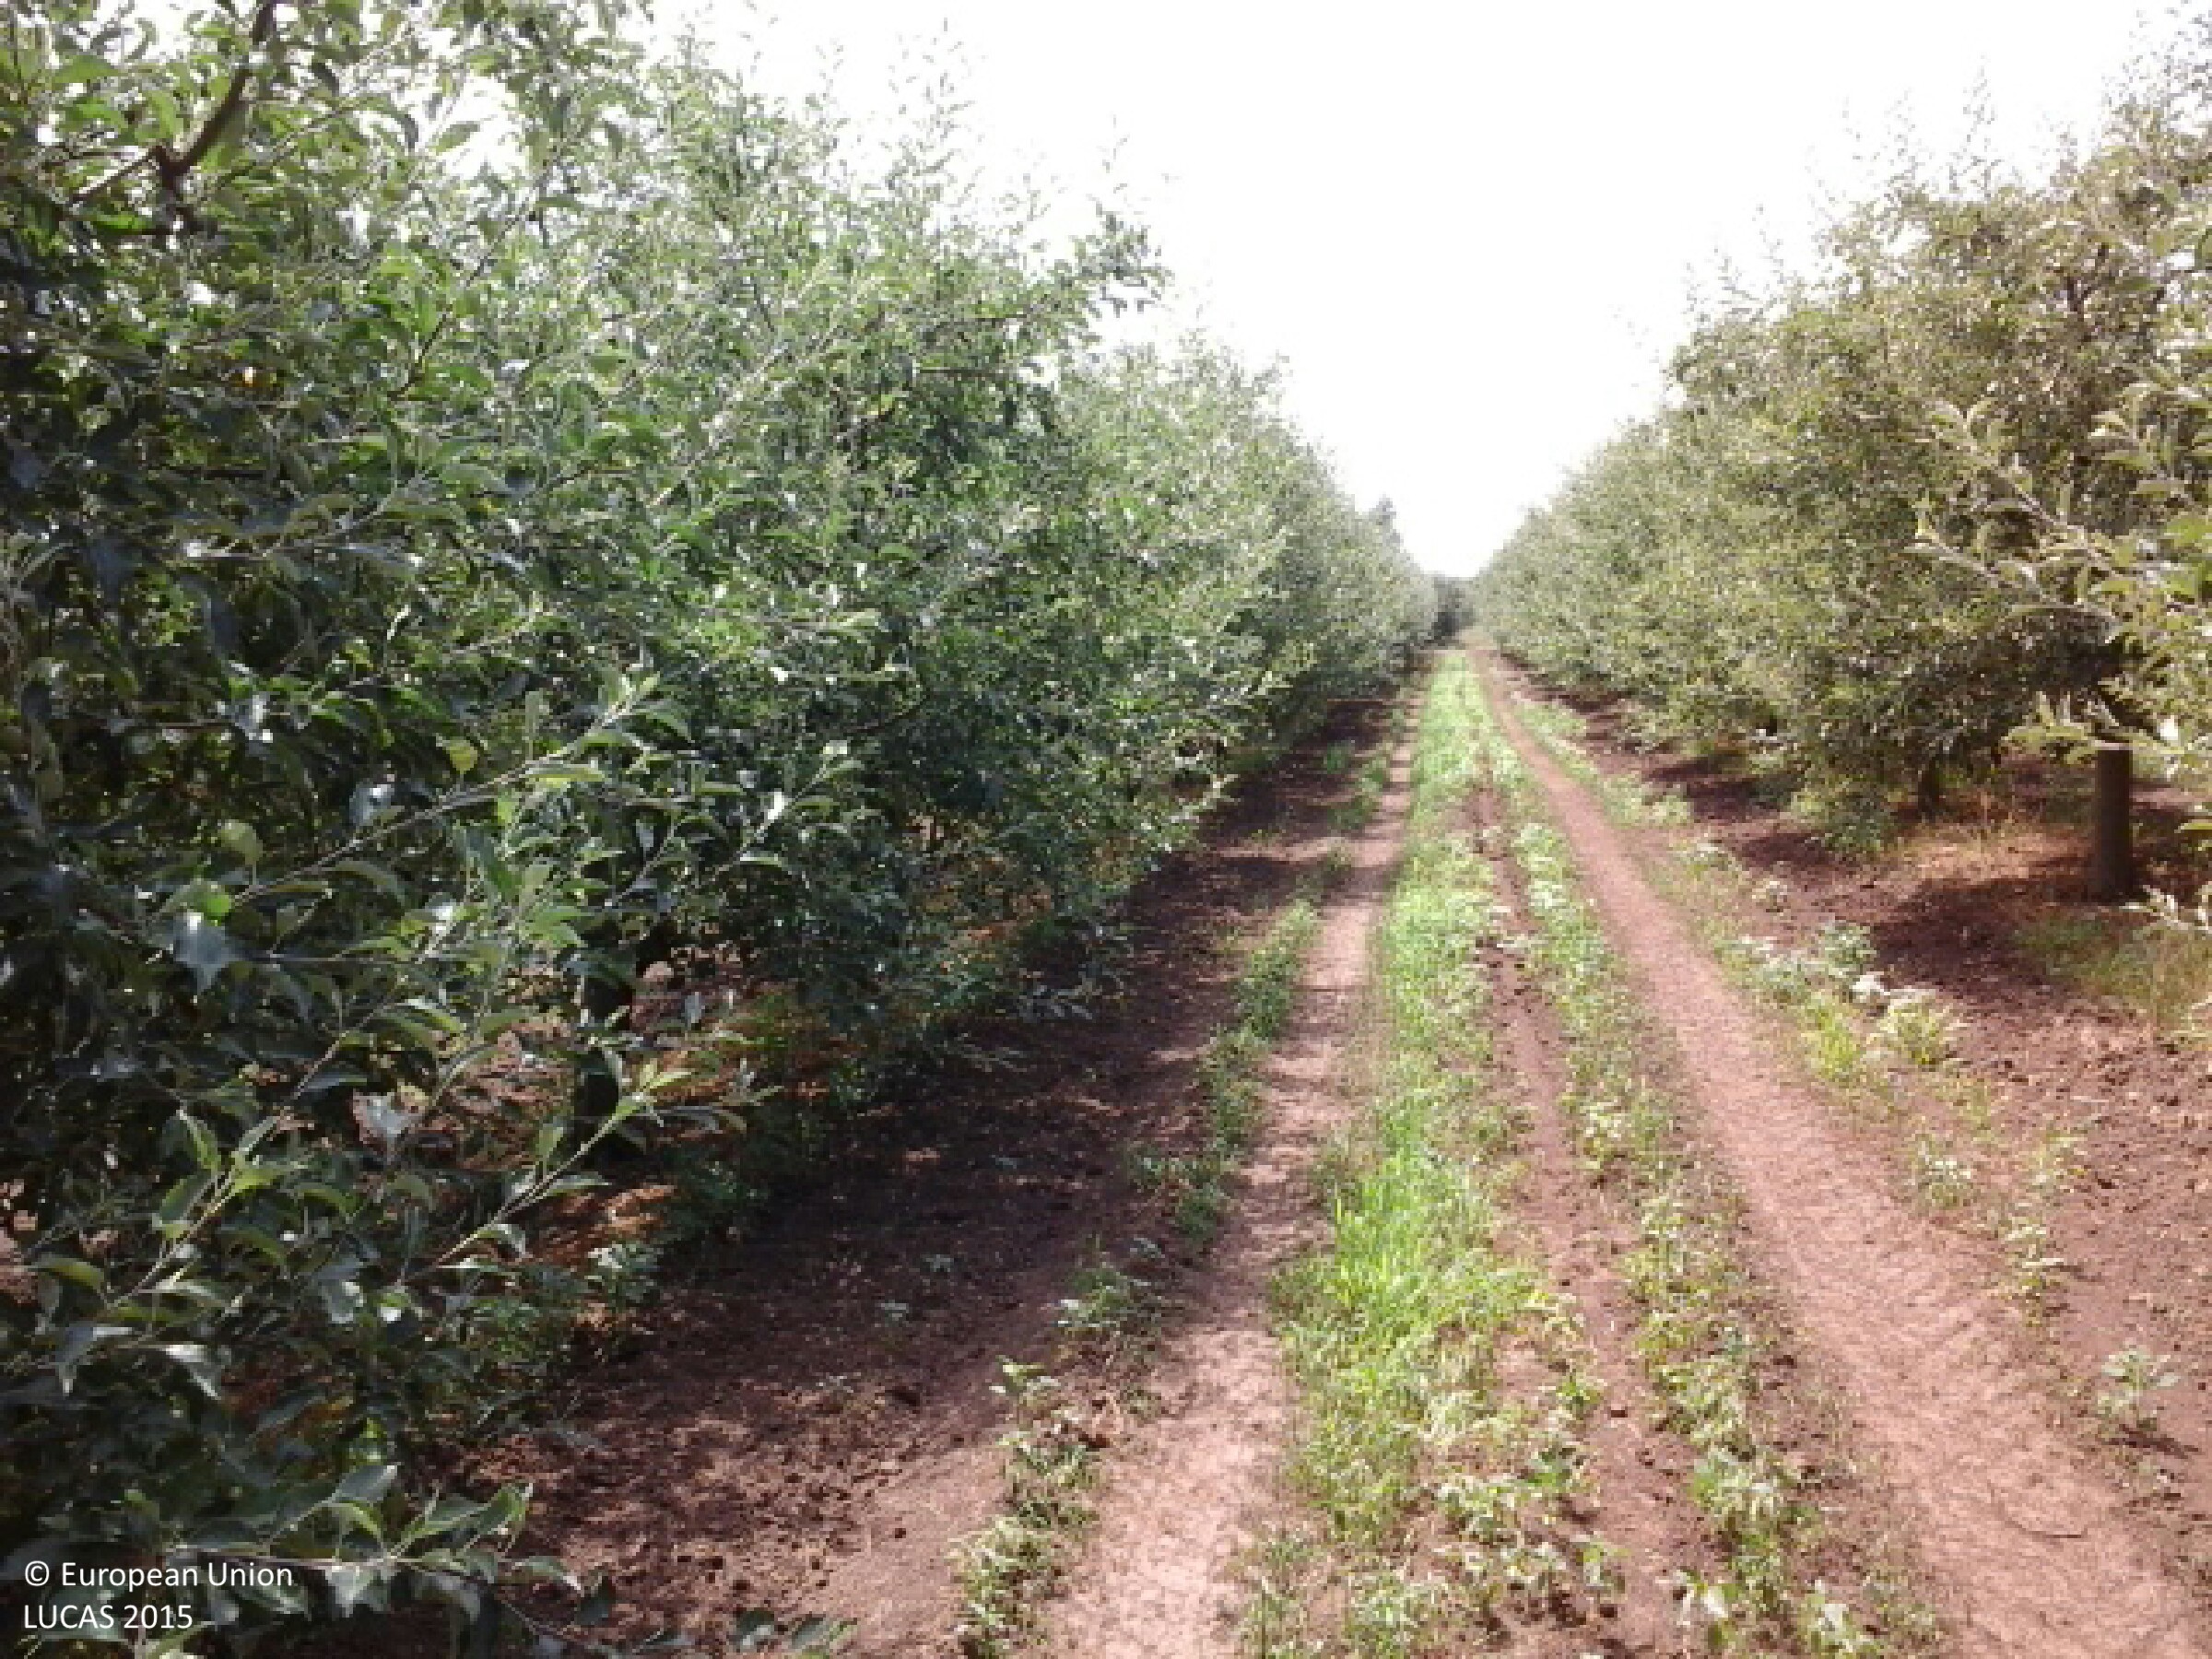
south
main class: Cropland
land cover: Apple fruit
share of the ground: 50 - 75 %
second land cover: Grassland without tree/shrub cover
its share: > 75 %
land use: Agriculture (excluding fallow land and kitchen gardens)
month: June
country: HU
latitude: 47.8390
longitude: 21.6574
